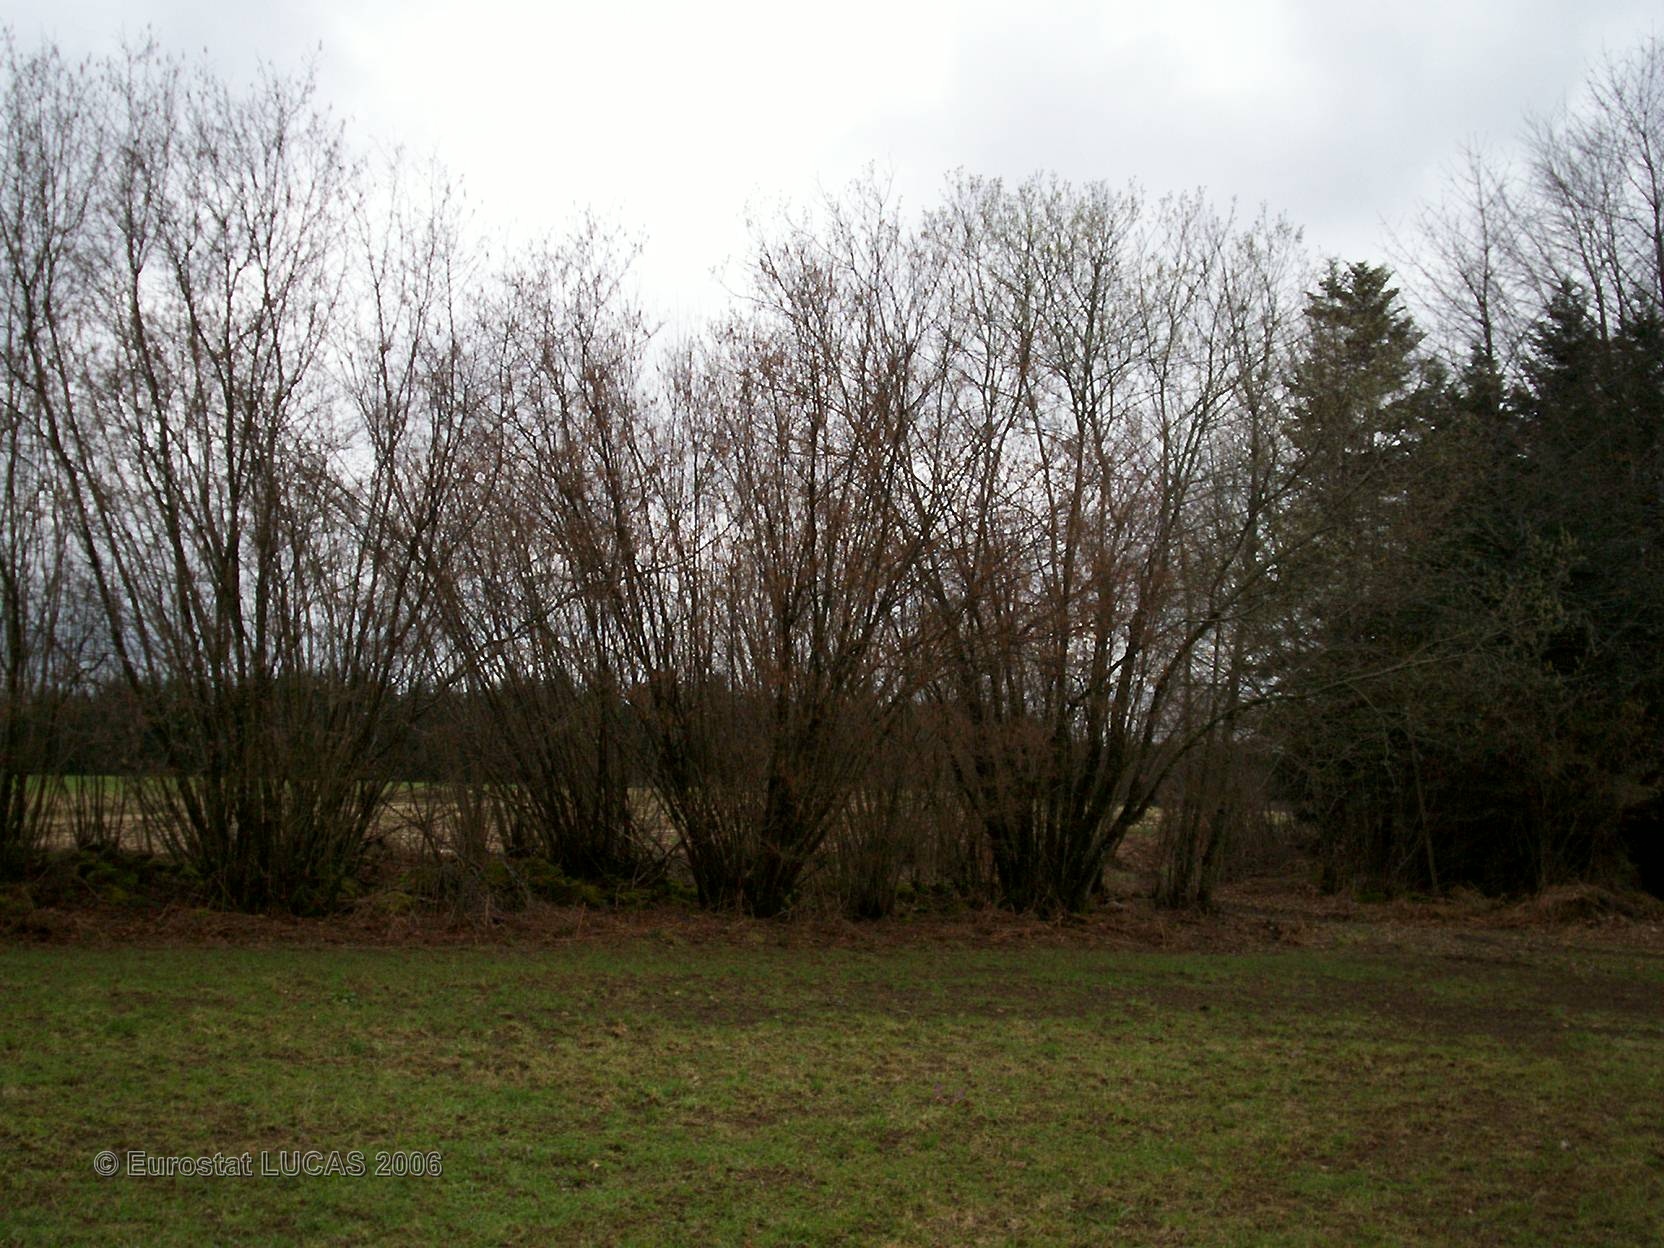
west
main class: Grassland
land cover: Grassland without tree/shrub cover
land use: Agriculture (excluding fallow land and kitchen gardens)
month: April
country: FR
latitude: 47.9521
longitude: 6.5062
